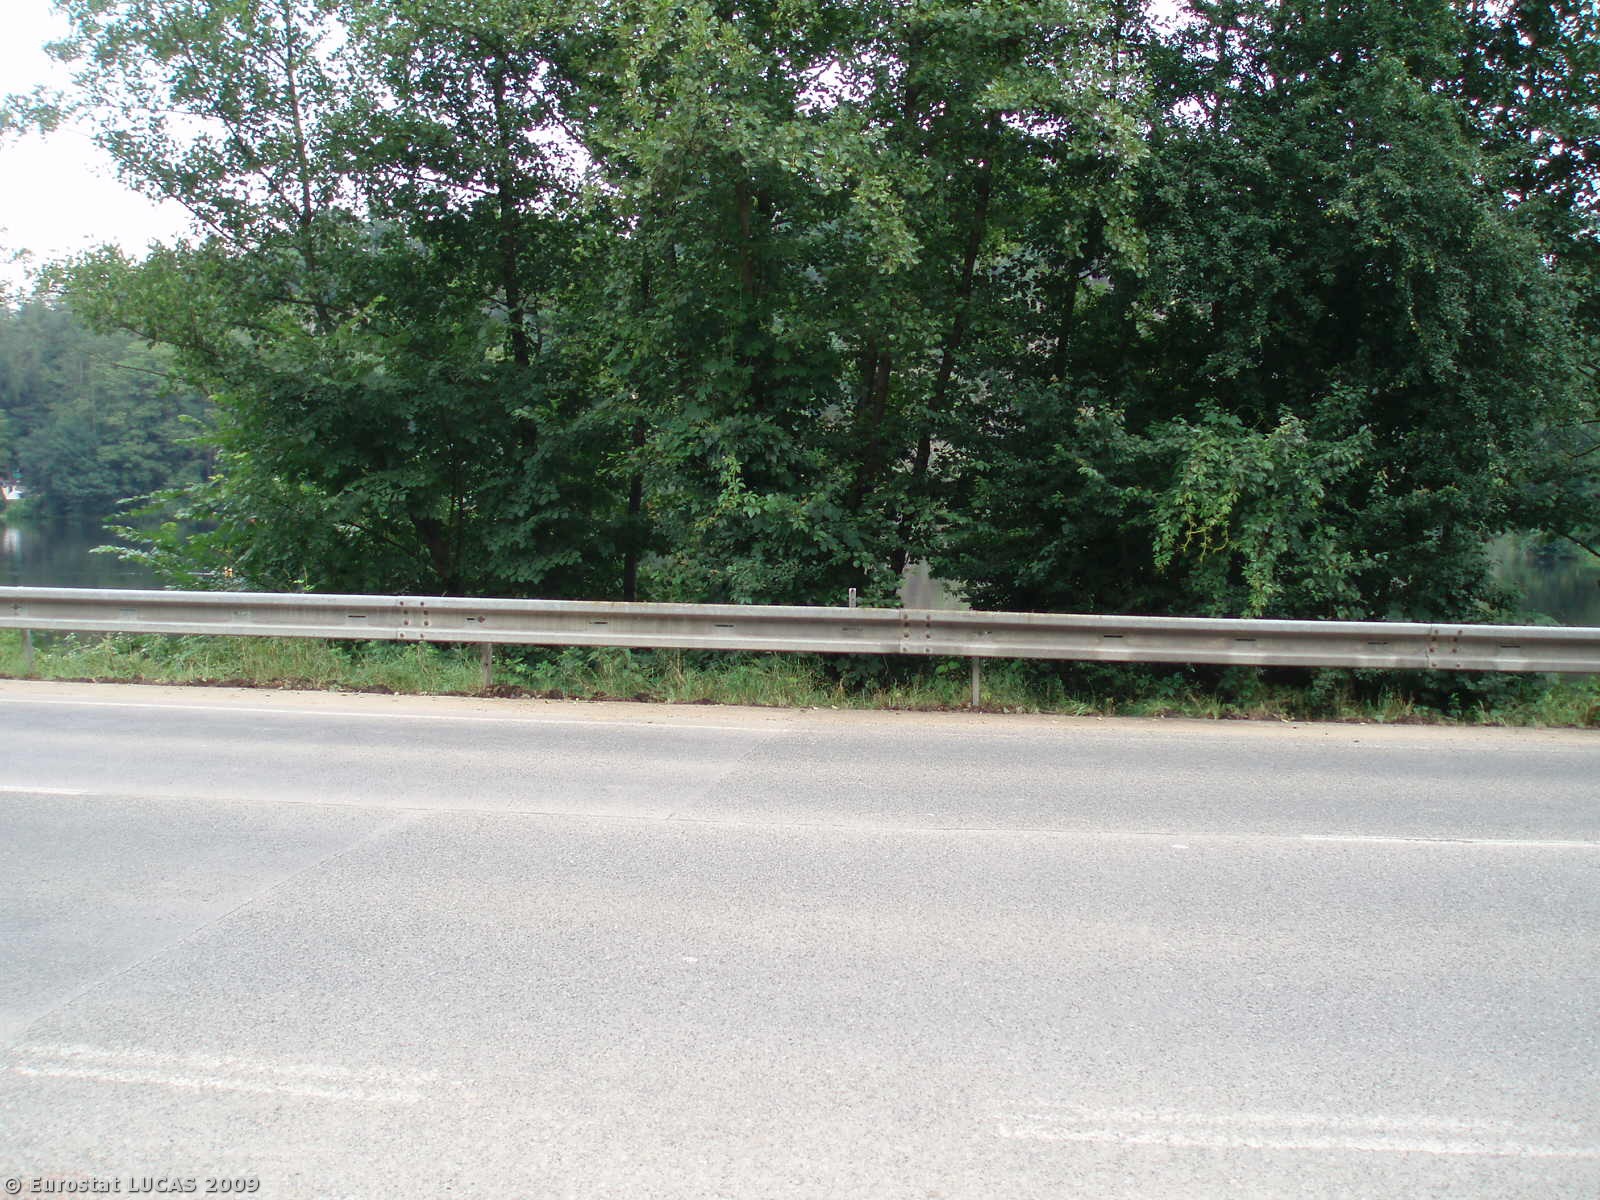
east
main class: Woodland
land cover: Broadleaved woodland
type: mesophytic deciduous forest
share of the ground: > 75 %
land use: Unused
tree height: > 5 m
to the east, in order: Broadleaved woodland; Mixed woodland; Artificial constructions in urban areas; Paved roads, cycling and walking lanes; Broadleaved woodland; Inland running water
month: July
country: CZ
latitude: 49.8838
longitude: 14.3854
